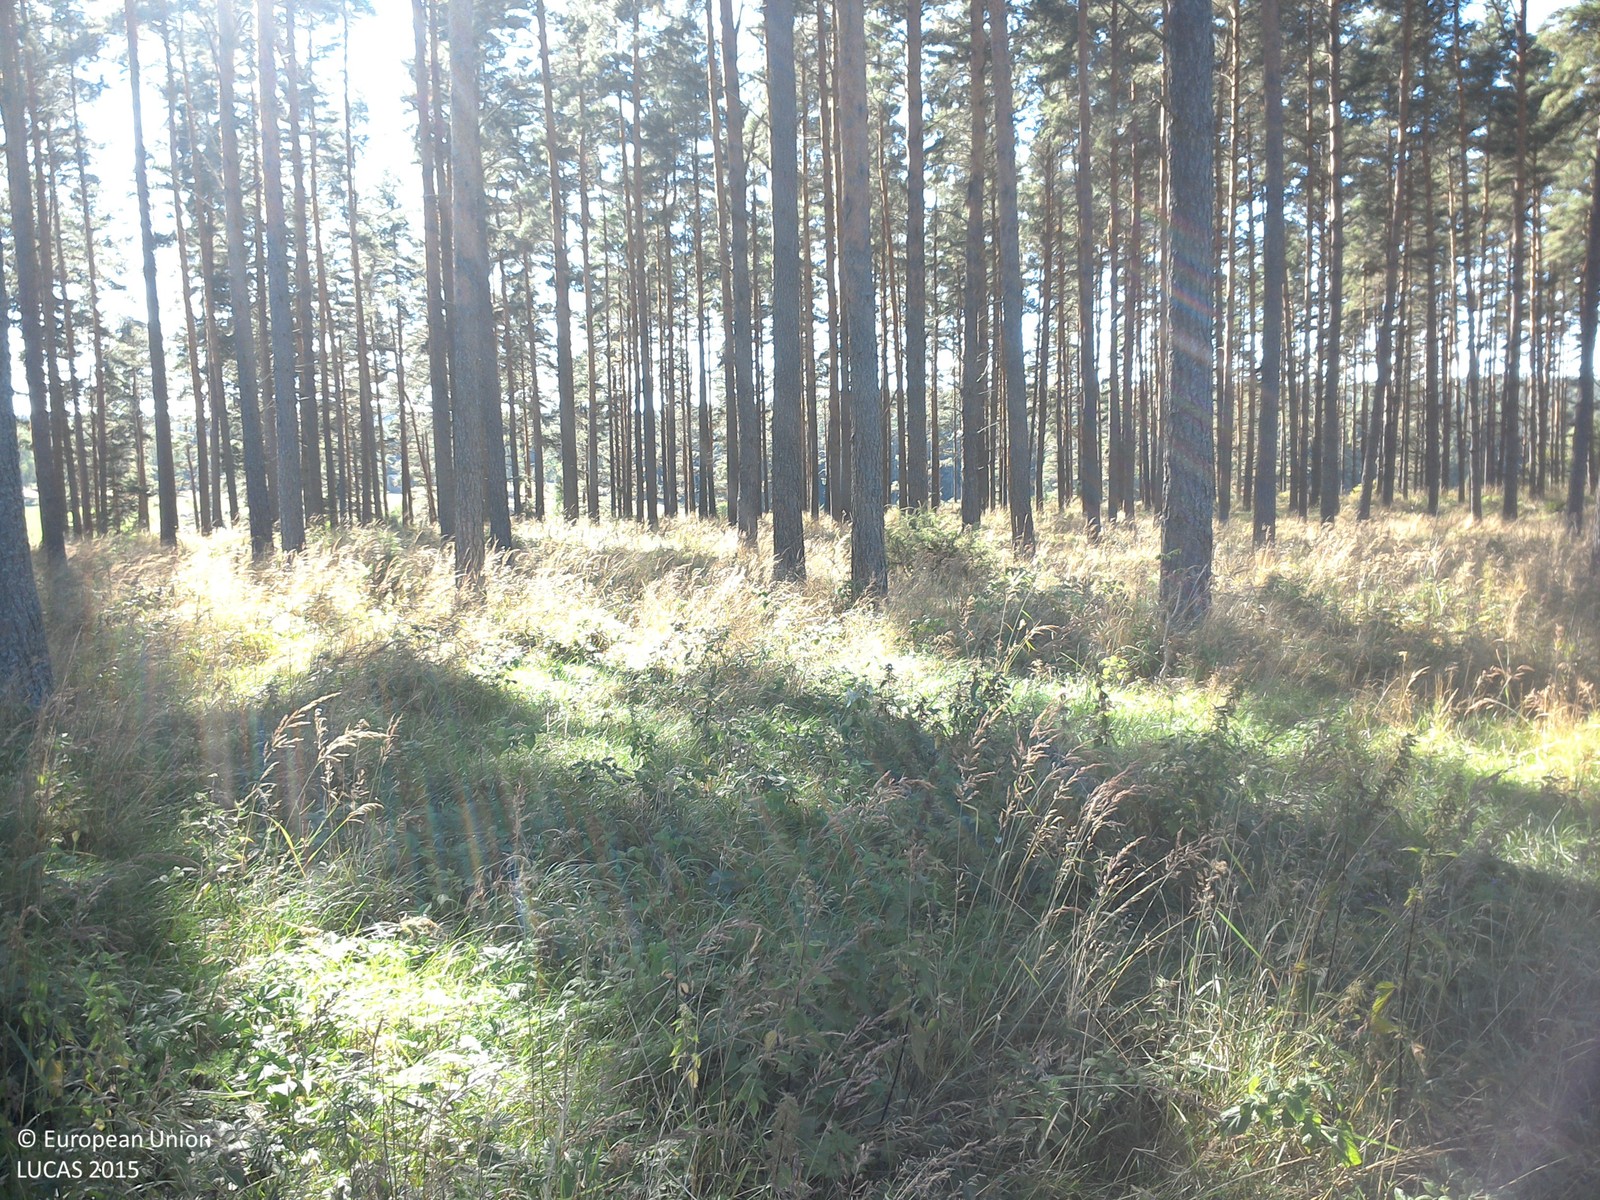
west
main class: Woodland
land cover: Pine dominated coniferous woodland
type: boreal forest
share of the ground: 50 - 75 %
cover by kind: coniferous forest trees 60 %, herbaceous plants 40 %
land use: Agriculture (excluding fallow land and kitchen gardens)
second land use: Forestry
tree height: > 5 m
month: August
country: SE
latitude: 58.0816
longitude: 15.2349
